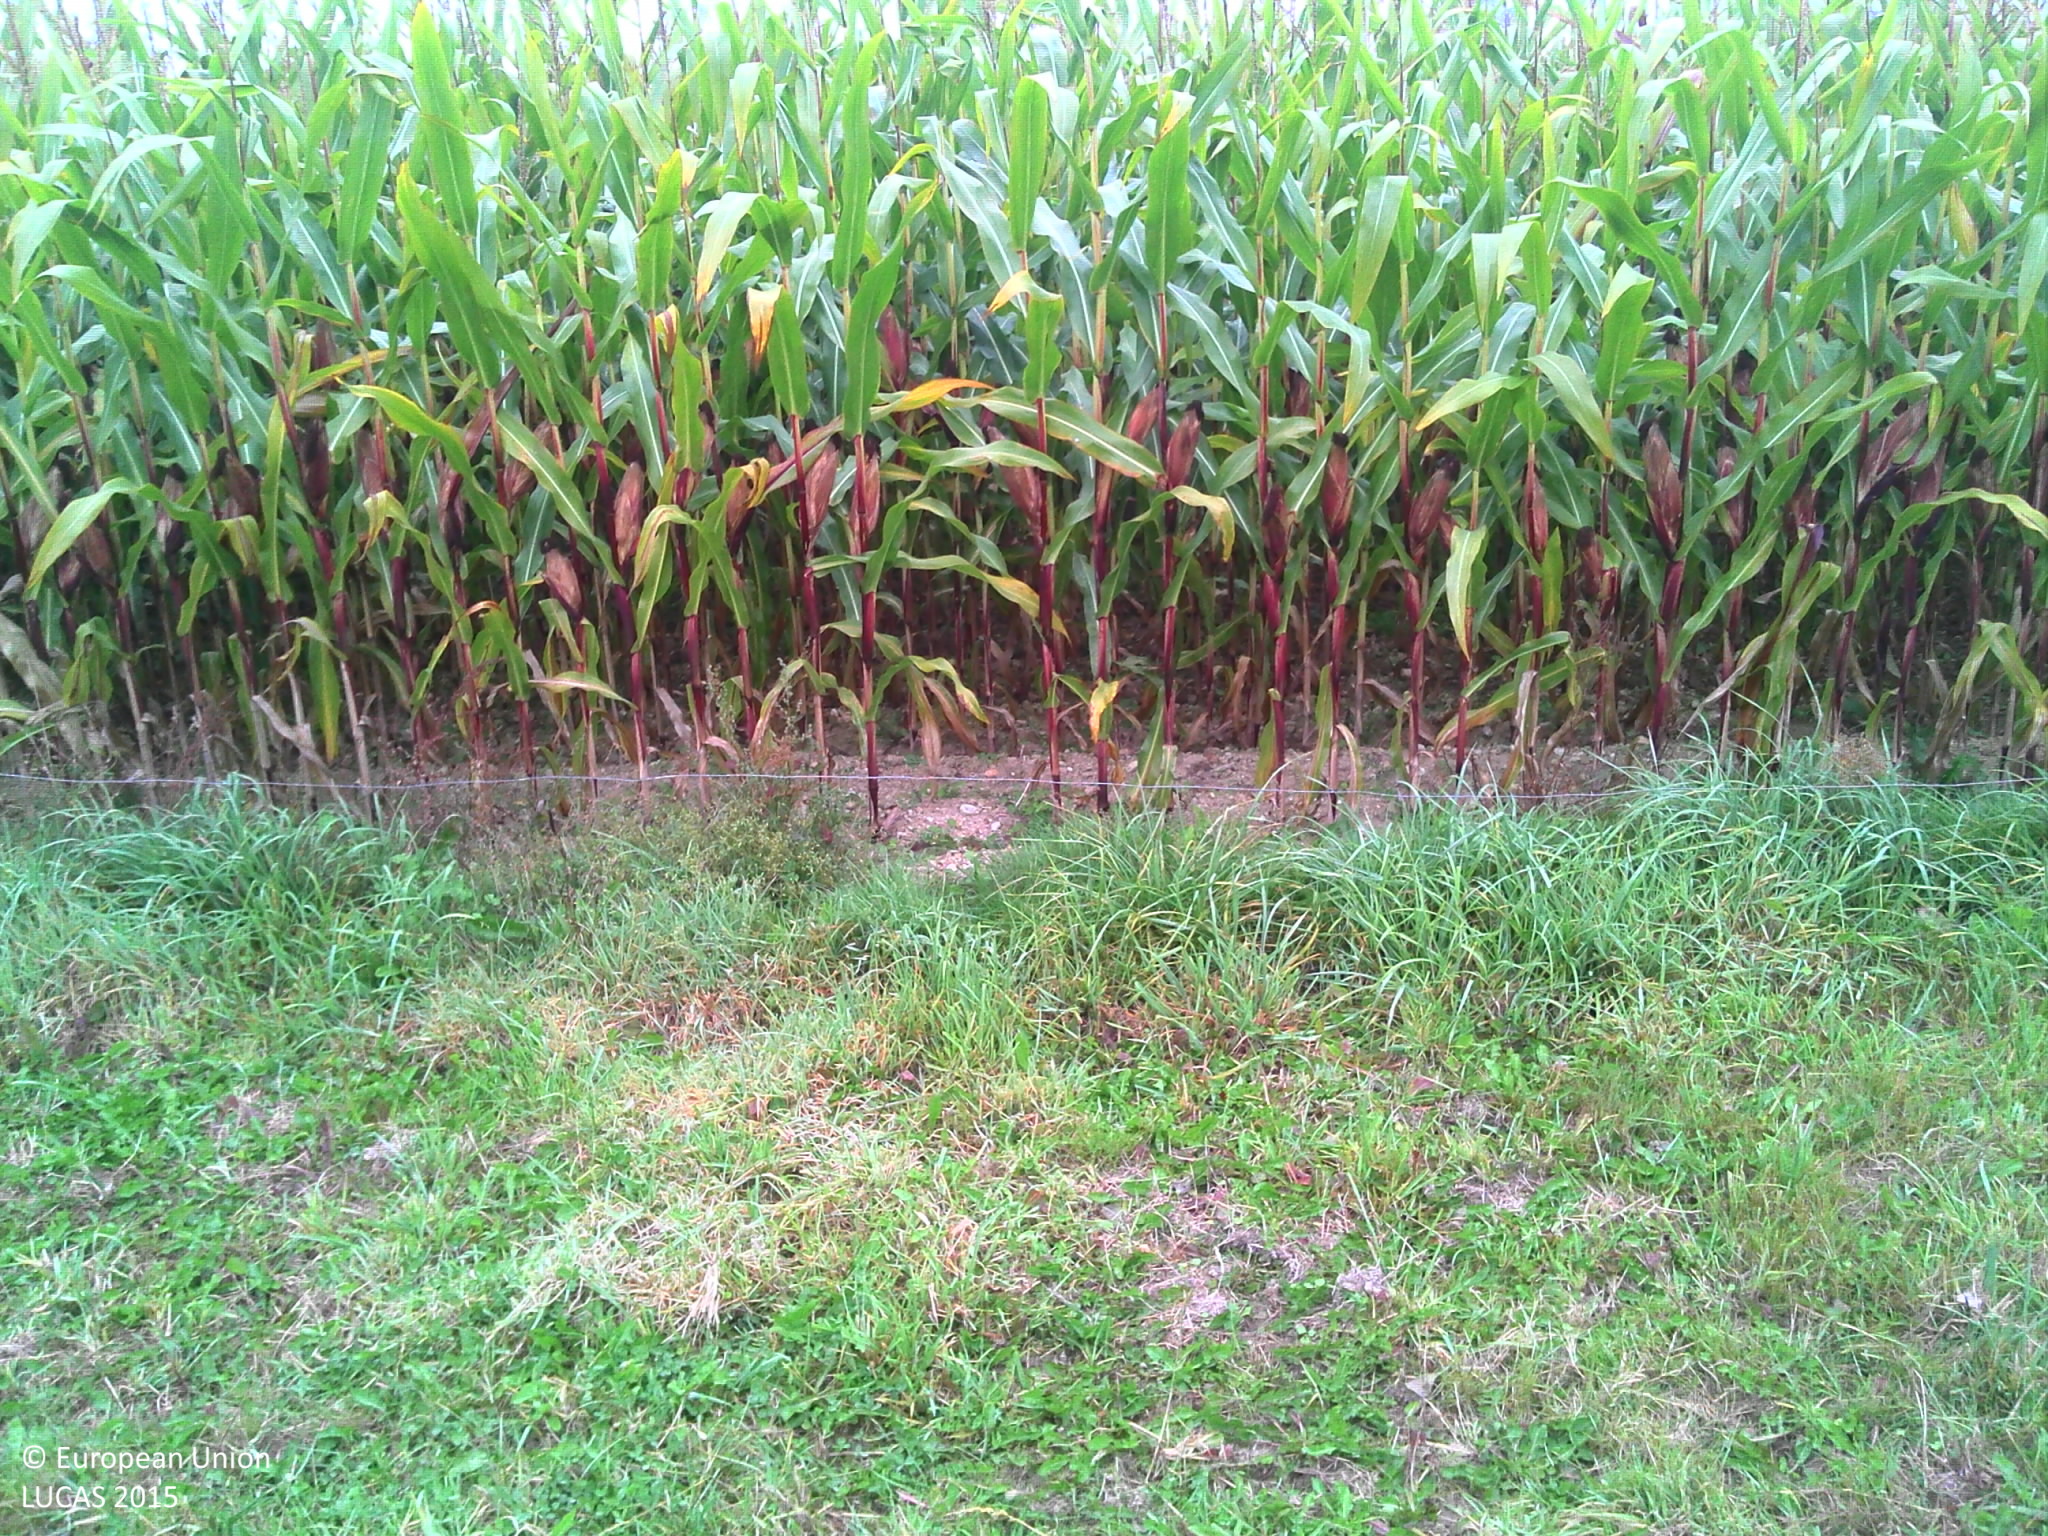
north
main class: Grassland
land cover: Grassland without tree/shrub cover
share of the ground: > 75 %
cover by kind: herbaceous plants 100 %
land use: Agriculture (excluding fallow land and kitchen gardens)
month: October
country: FR
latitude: 47.9434
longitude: -2.3607
